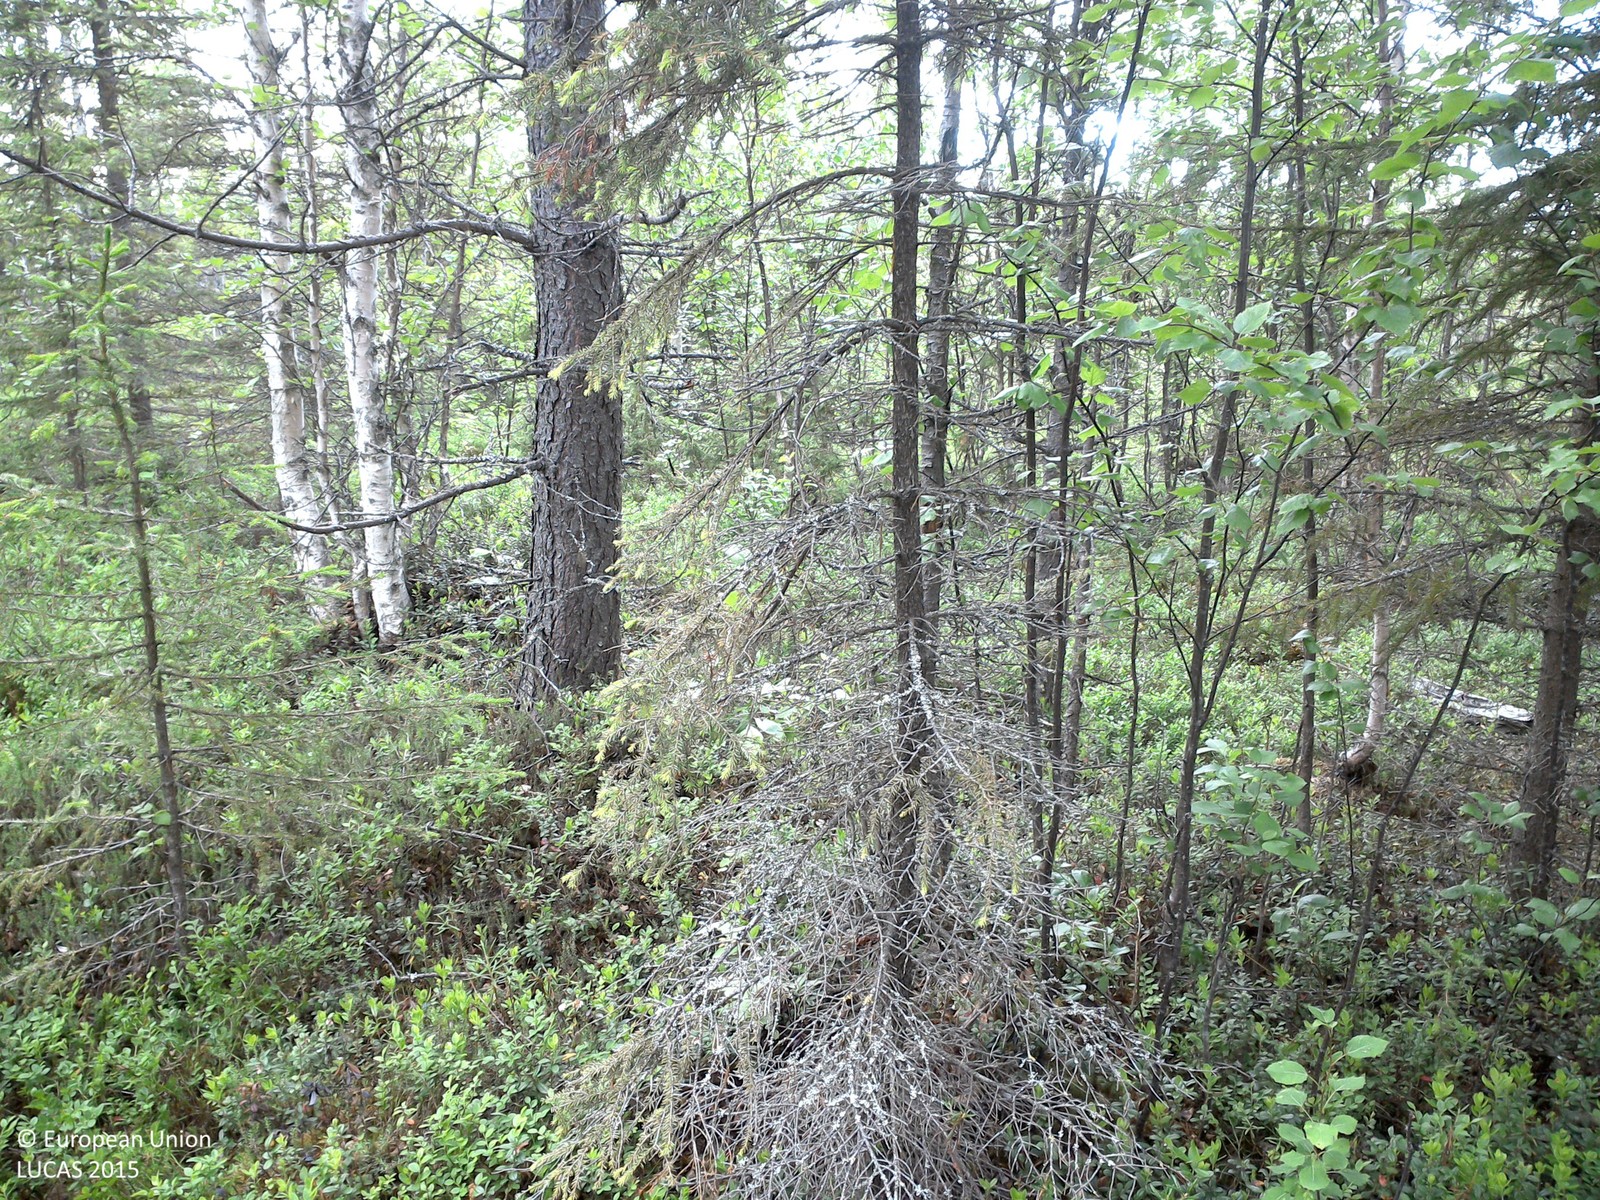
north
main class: Woodland
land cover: Pine dominated mixed woodland
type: boreal forest
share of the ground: 25 - 50 %
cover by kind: shrubs 60 %, coniferous forest trees 25 %, broadleaved forest trees 10 %, lichens and mosses 5 %
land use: Forestry
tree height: > 5 m
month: July
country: SE
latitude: 66.8554
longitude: 23.7300
